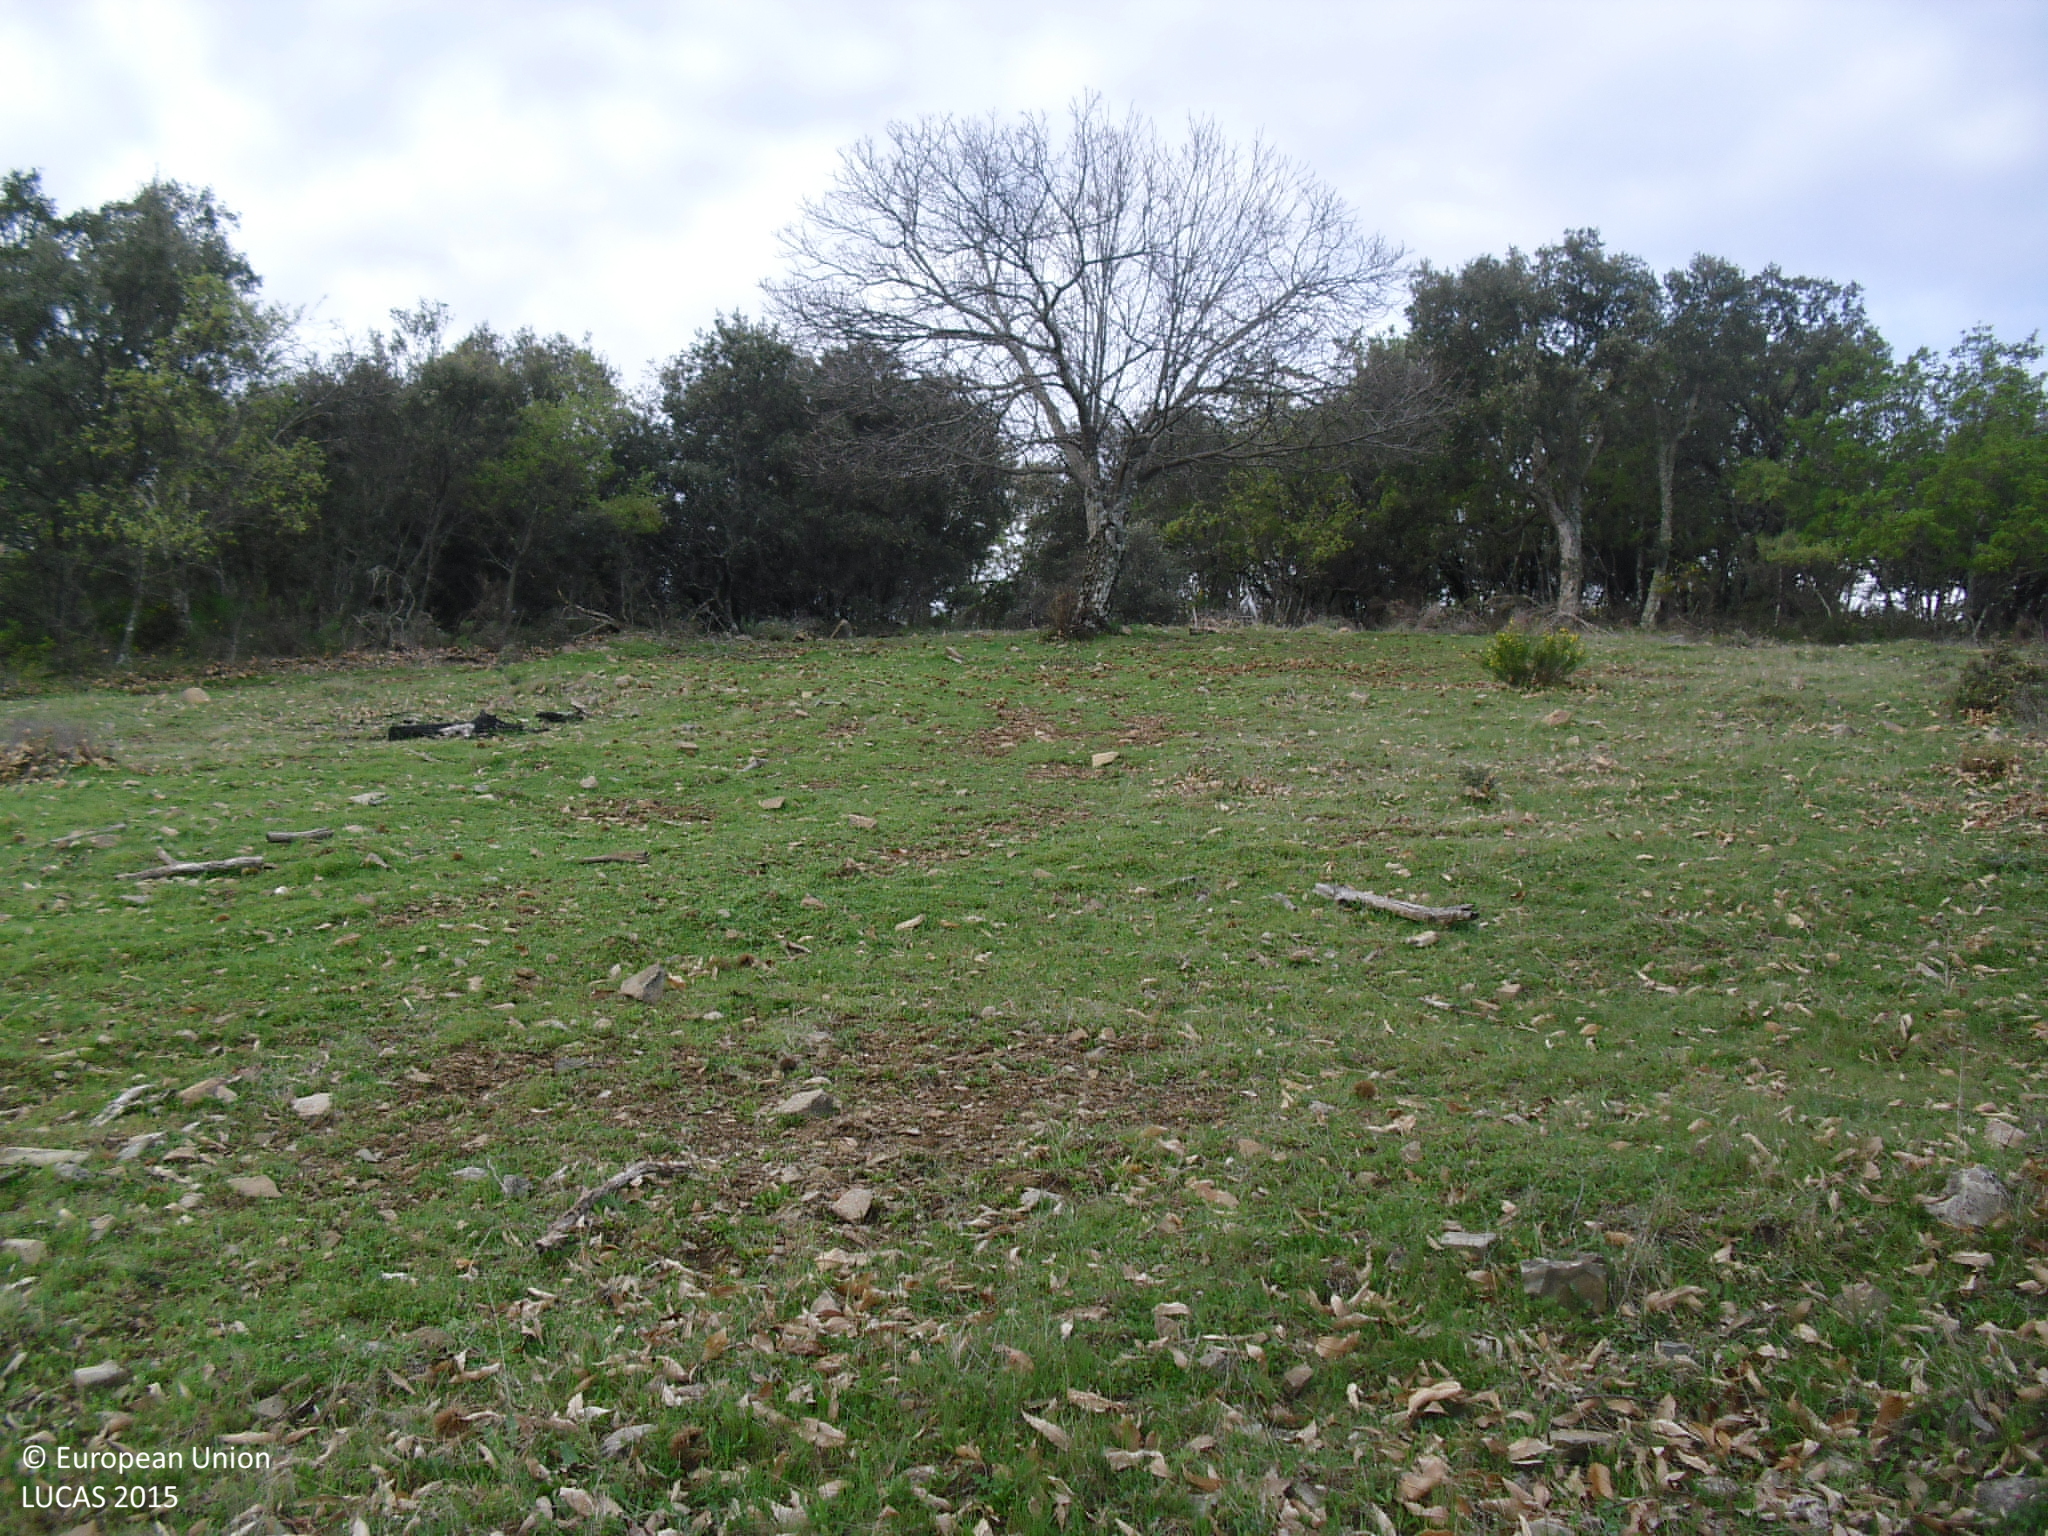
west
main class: Woodland
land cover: Broadleaved woodland
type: thermophilous deciduous forest
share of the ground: 25 - 50 %
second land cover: Grassland without tree/shrub cover
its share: > 75 %
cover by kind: herbaceous plants 60 %, broadleaved forest trees 40 %
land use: Forestry
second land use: Agriculture (excluding fallow land and kitchen gardens)
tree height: > 5 m
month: April
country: ES
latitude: 39.5154
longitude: -5.3212
